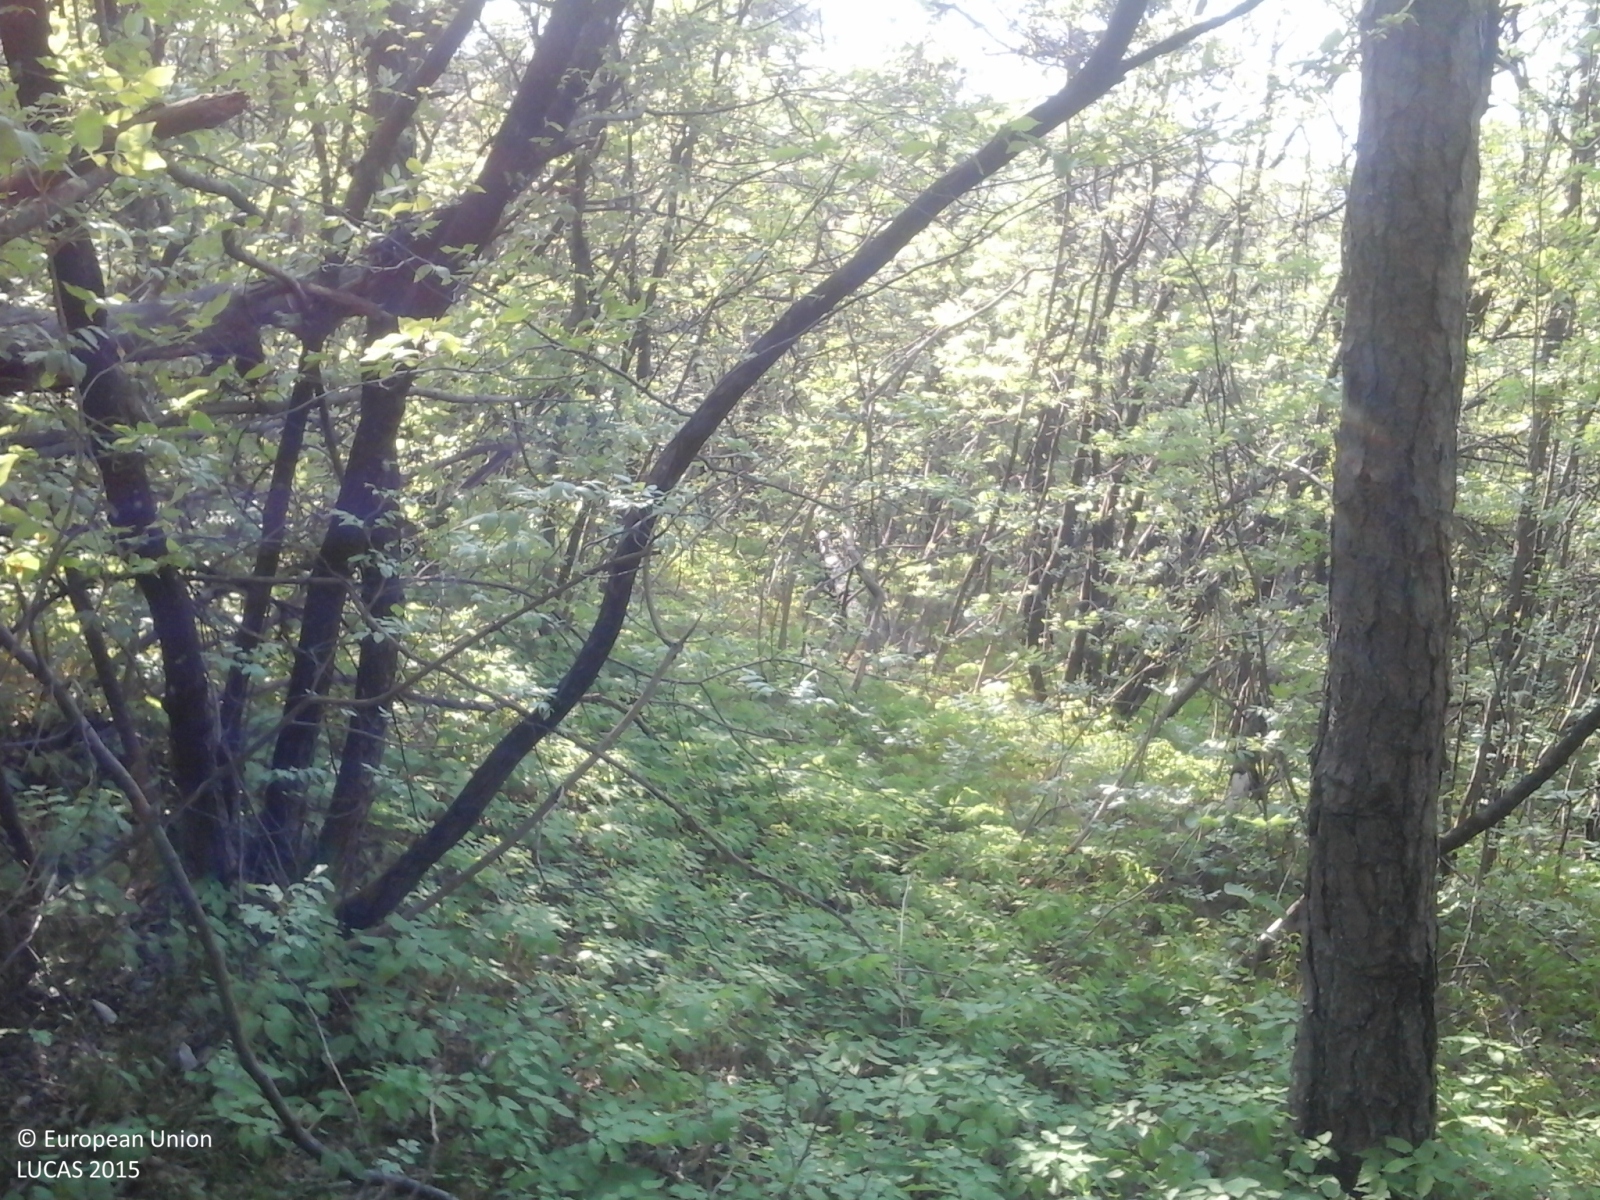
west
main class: Woodland
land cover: Broadleaved woodland
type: thermophilous deciduous forest
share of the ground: > 75 %
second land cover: Grassland without tree/shrub cover
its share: > 75 %
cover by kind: broadleaved forest trees 95 %, coniferous forest trees 5 %
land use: Forestry
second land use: Sport
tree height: > 5 m
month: April
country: IT
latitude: 46.1111
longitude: 11.1241
